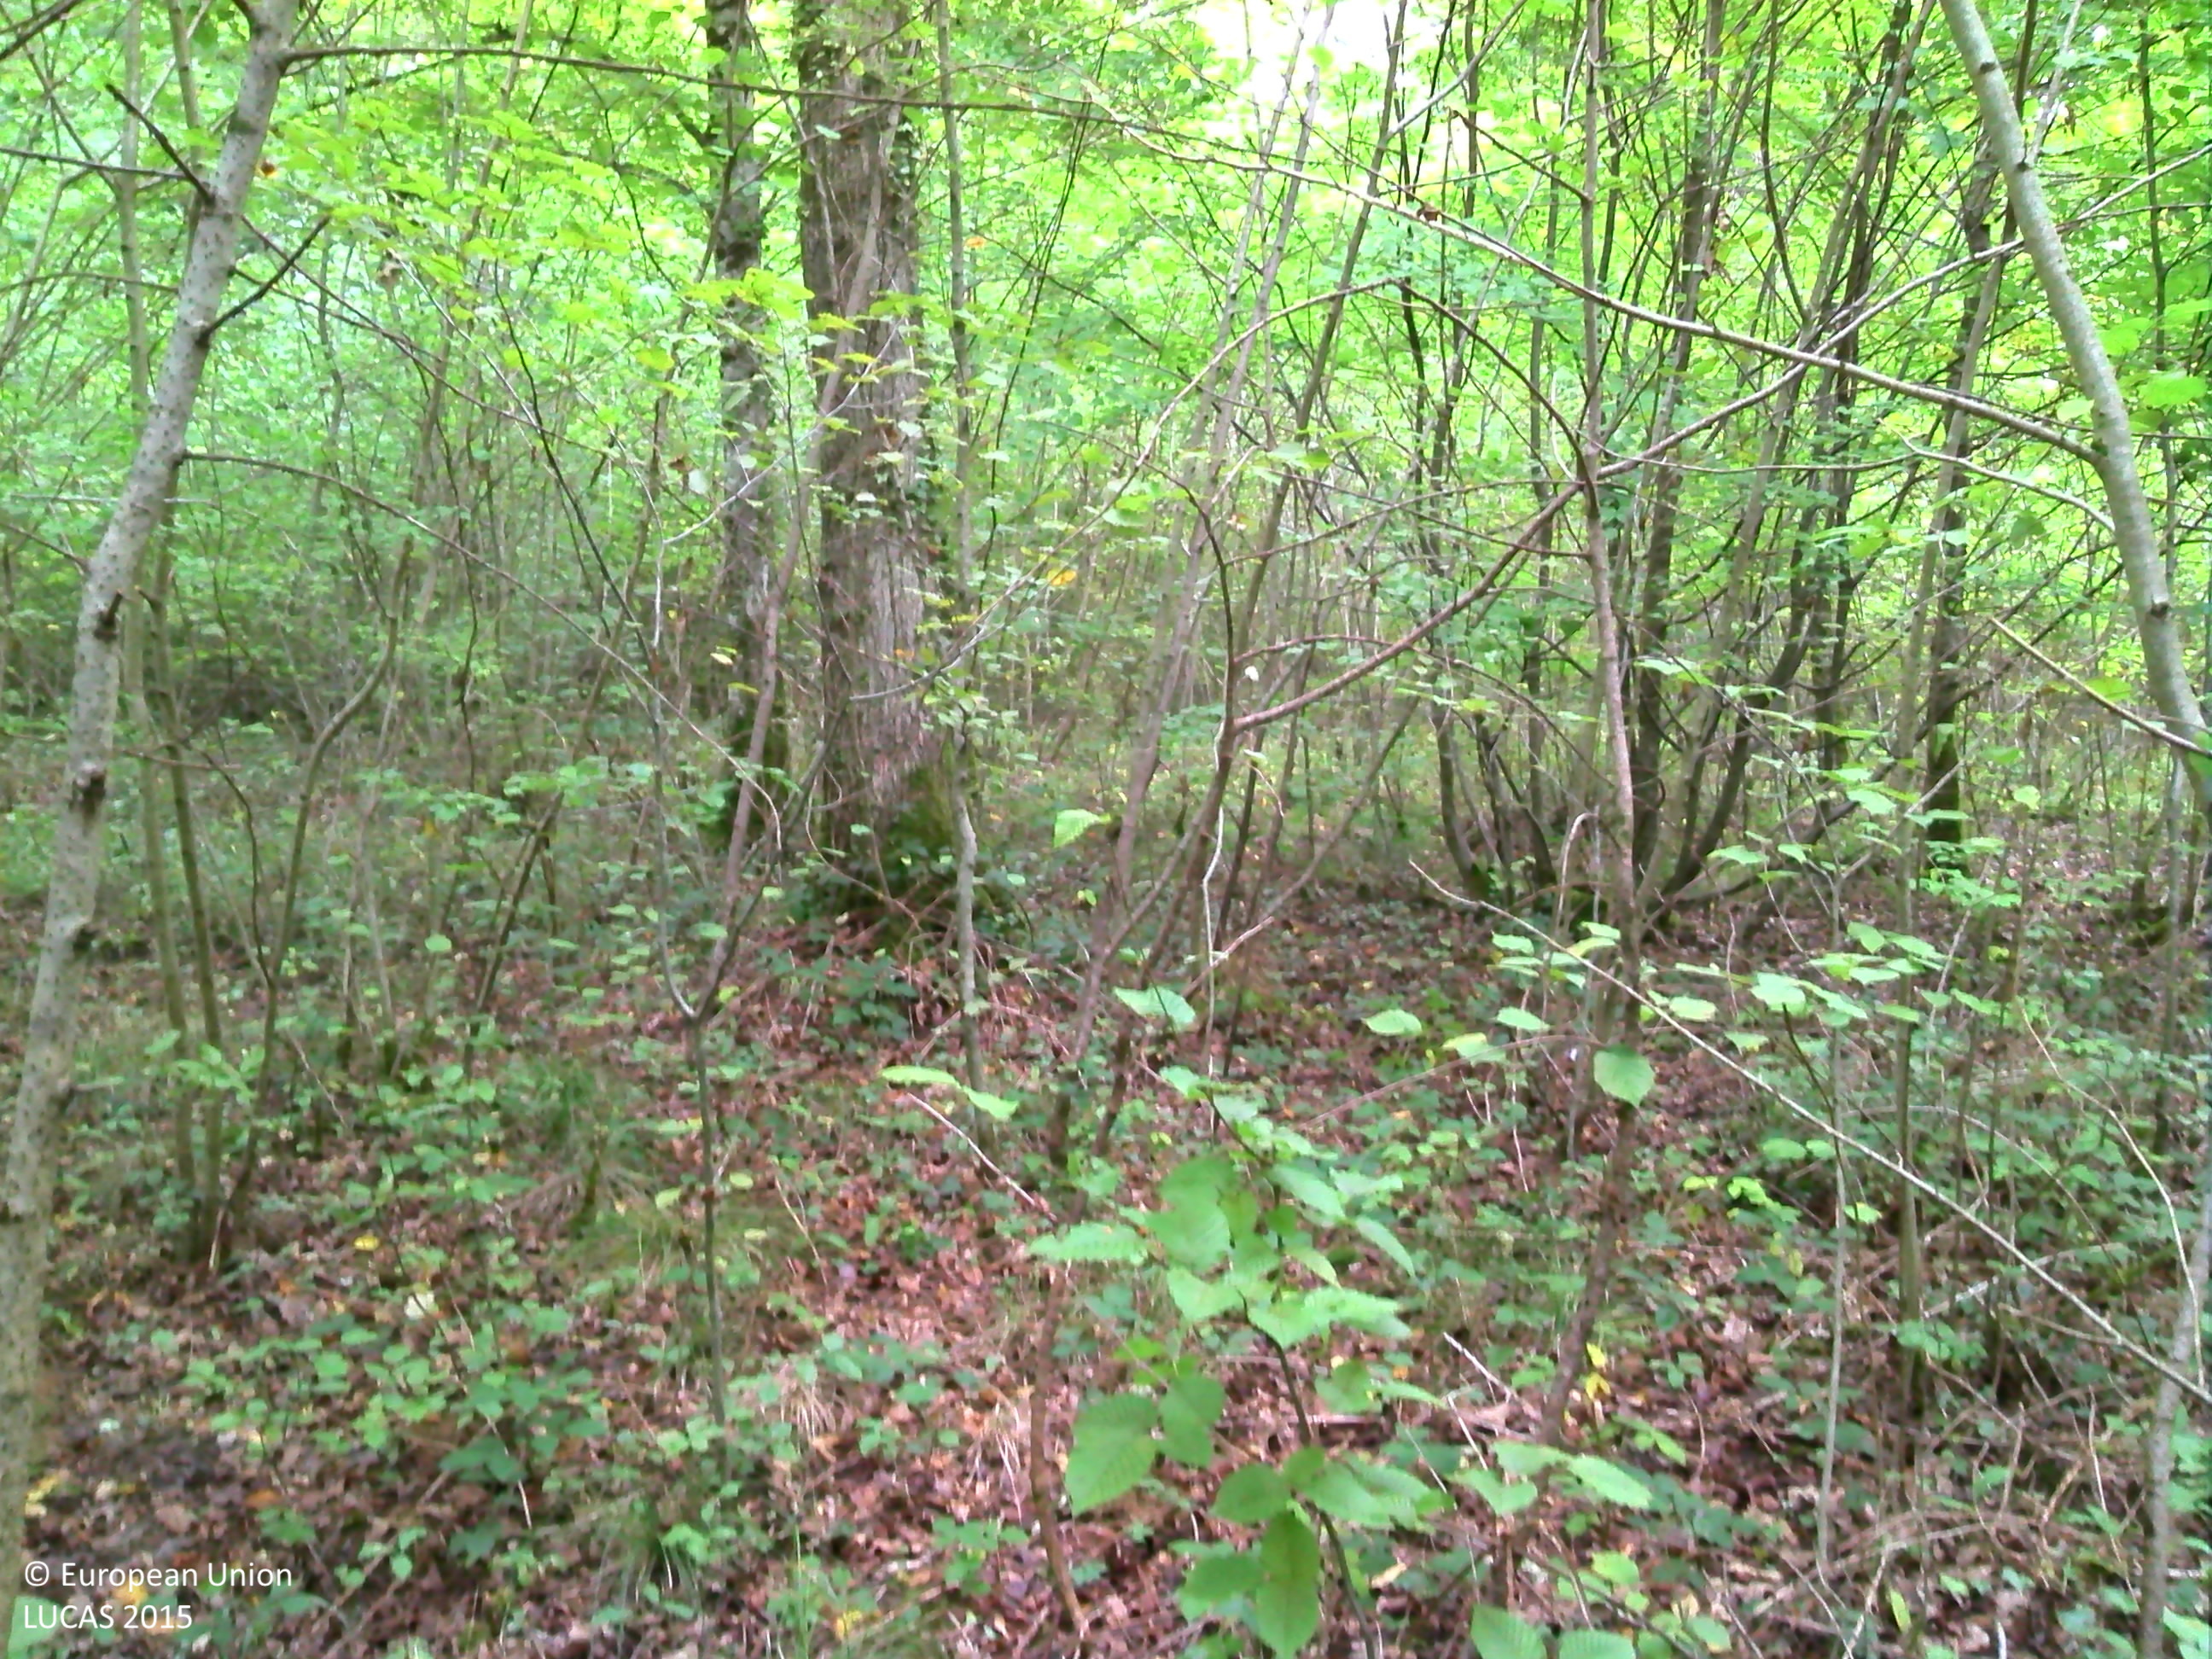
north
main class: Woodland
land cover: Broadleaved woodland
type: mesophytic deciduous forest
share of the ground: > 75 %
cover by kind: broadleaved forest trees 80 %, shrubs 10 %, herbaceous plants 5 %, lichens and mosses 5 %
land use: Forestry
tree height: > 5 m
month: September
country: FR
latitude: 48.3265
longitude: 4.6162
